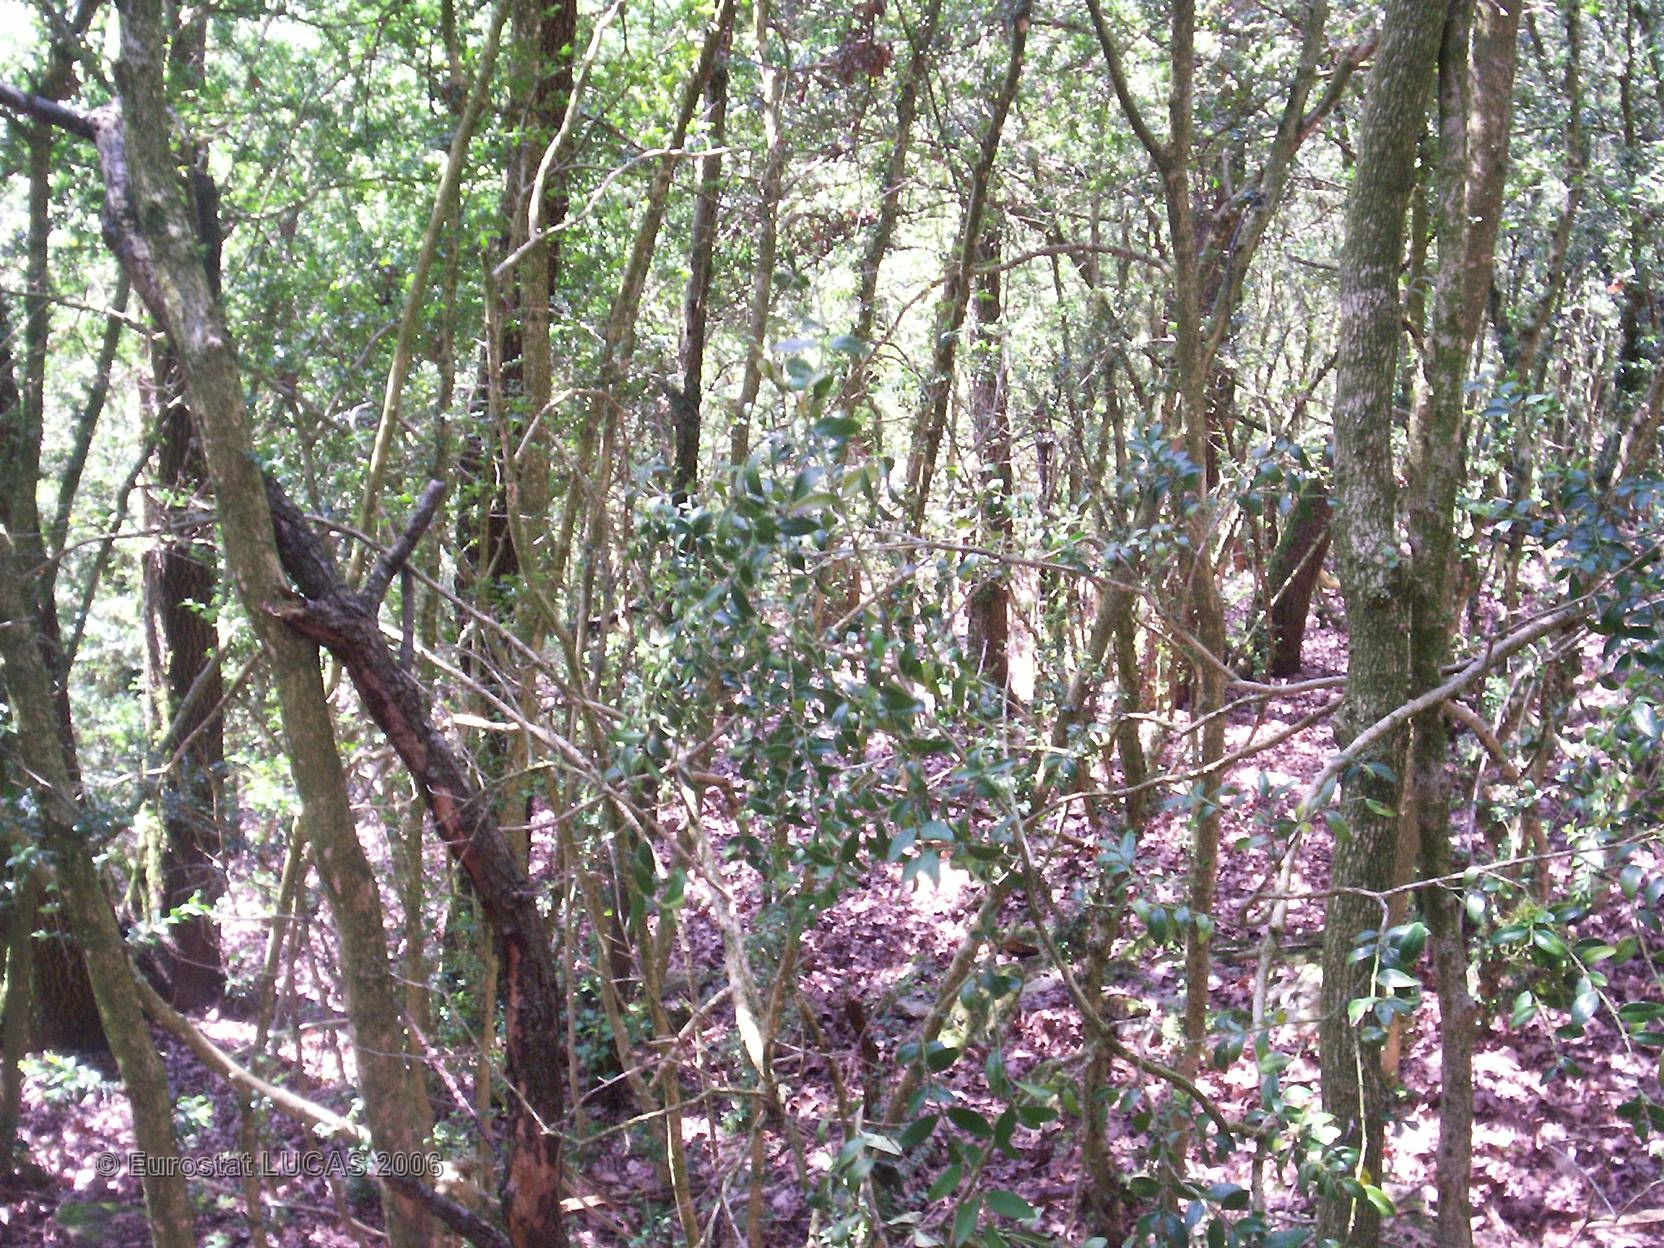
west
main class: Cropland
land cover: Barley
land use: Agriculture (excluding fallow land and kitchen gardens)
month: May
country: FR
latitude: 47.5125
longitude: 4.5684
